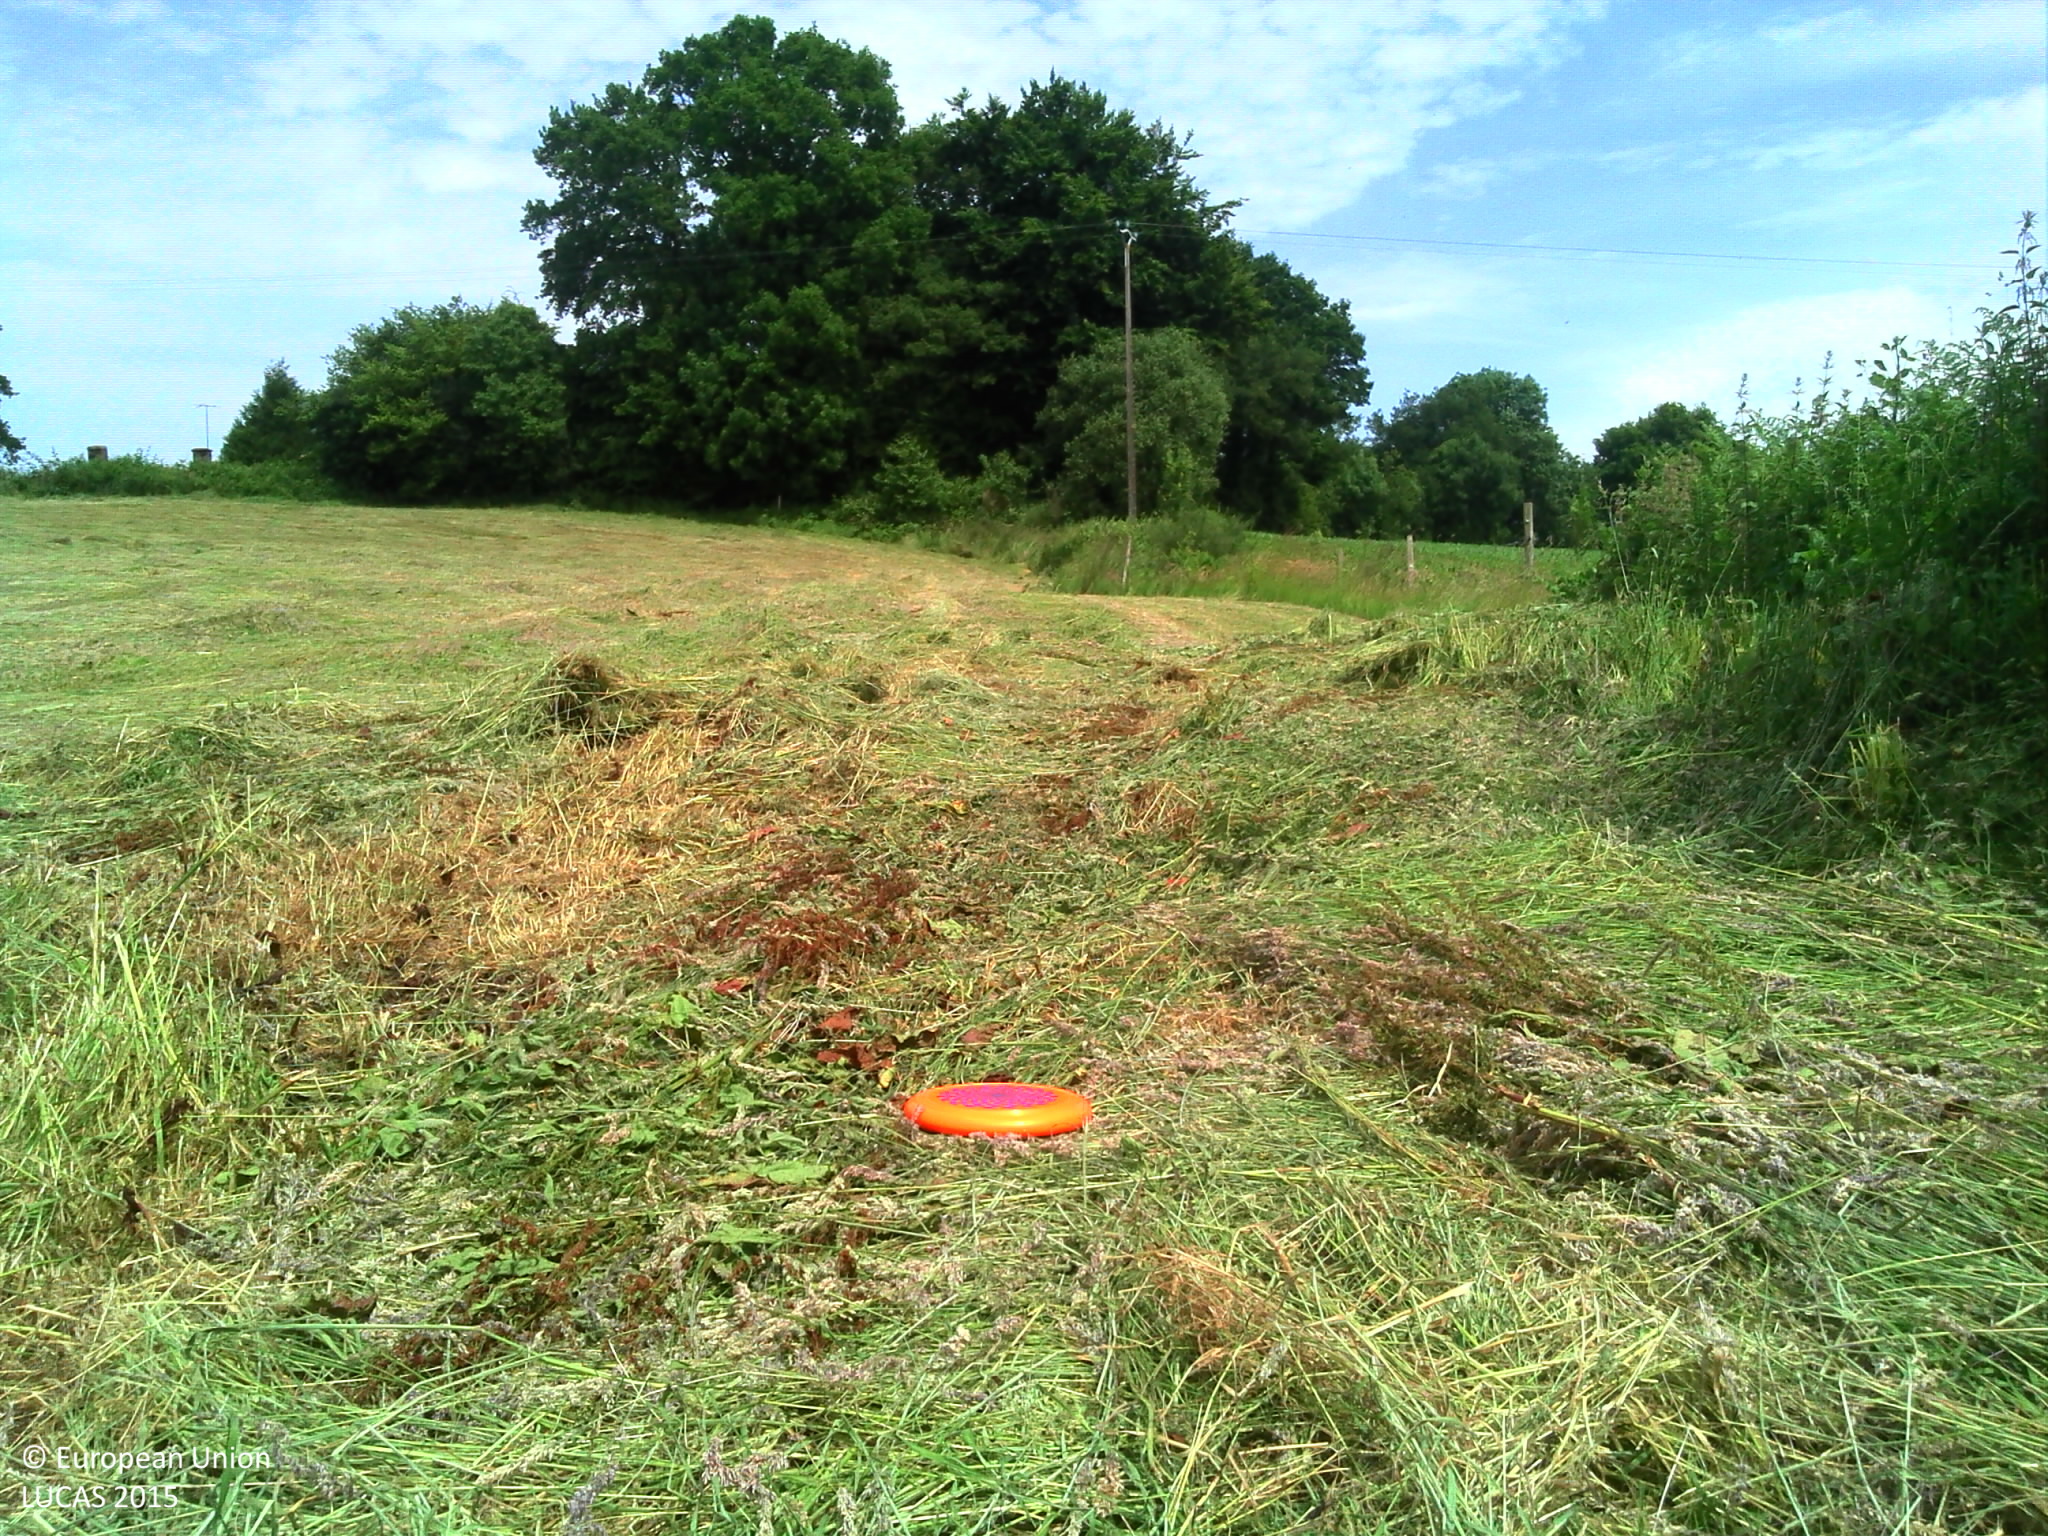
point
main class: Grassland
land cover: Grassland without tree/shrub cover
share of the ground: > 75 %
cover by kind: herbaceous plants 95 %
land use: Agriculture (excluding fallow land and kitchen gardens)
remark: Harvested field
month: June
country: FR
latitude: 48.5872
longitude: -0.1585
